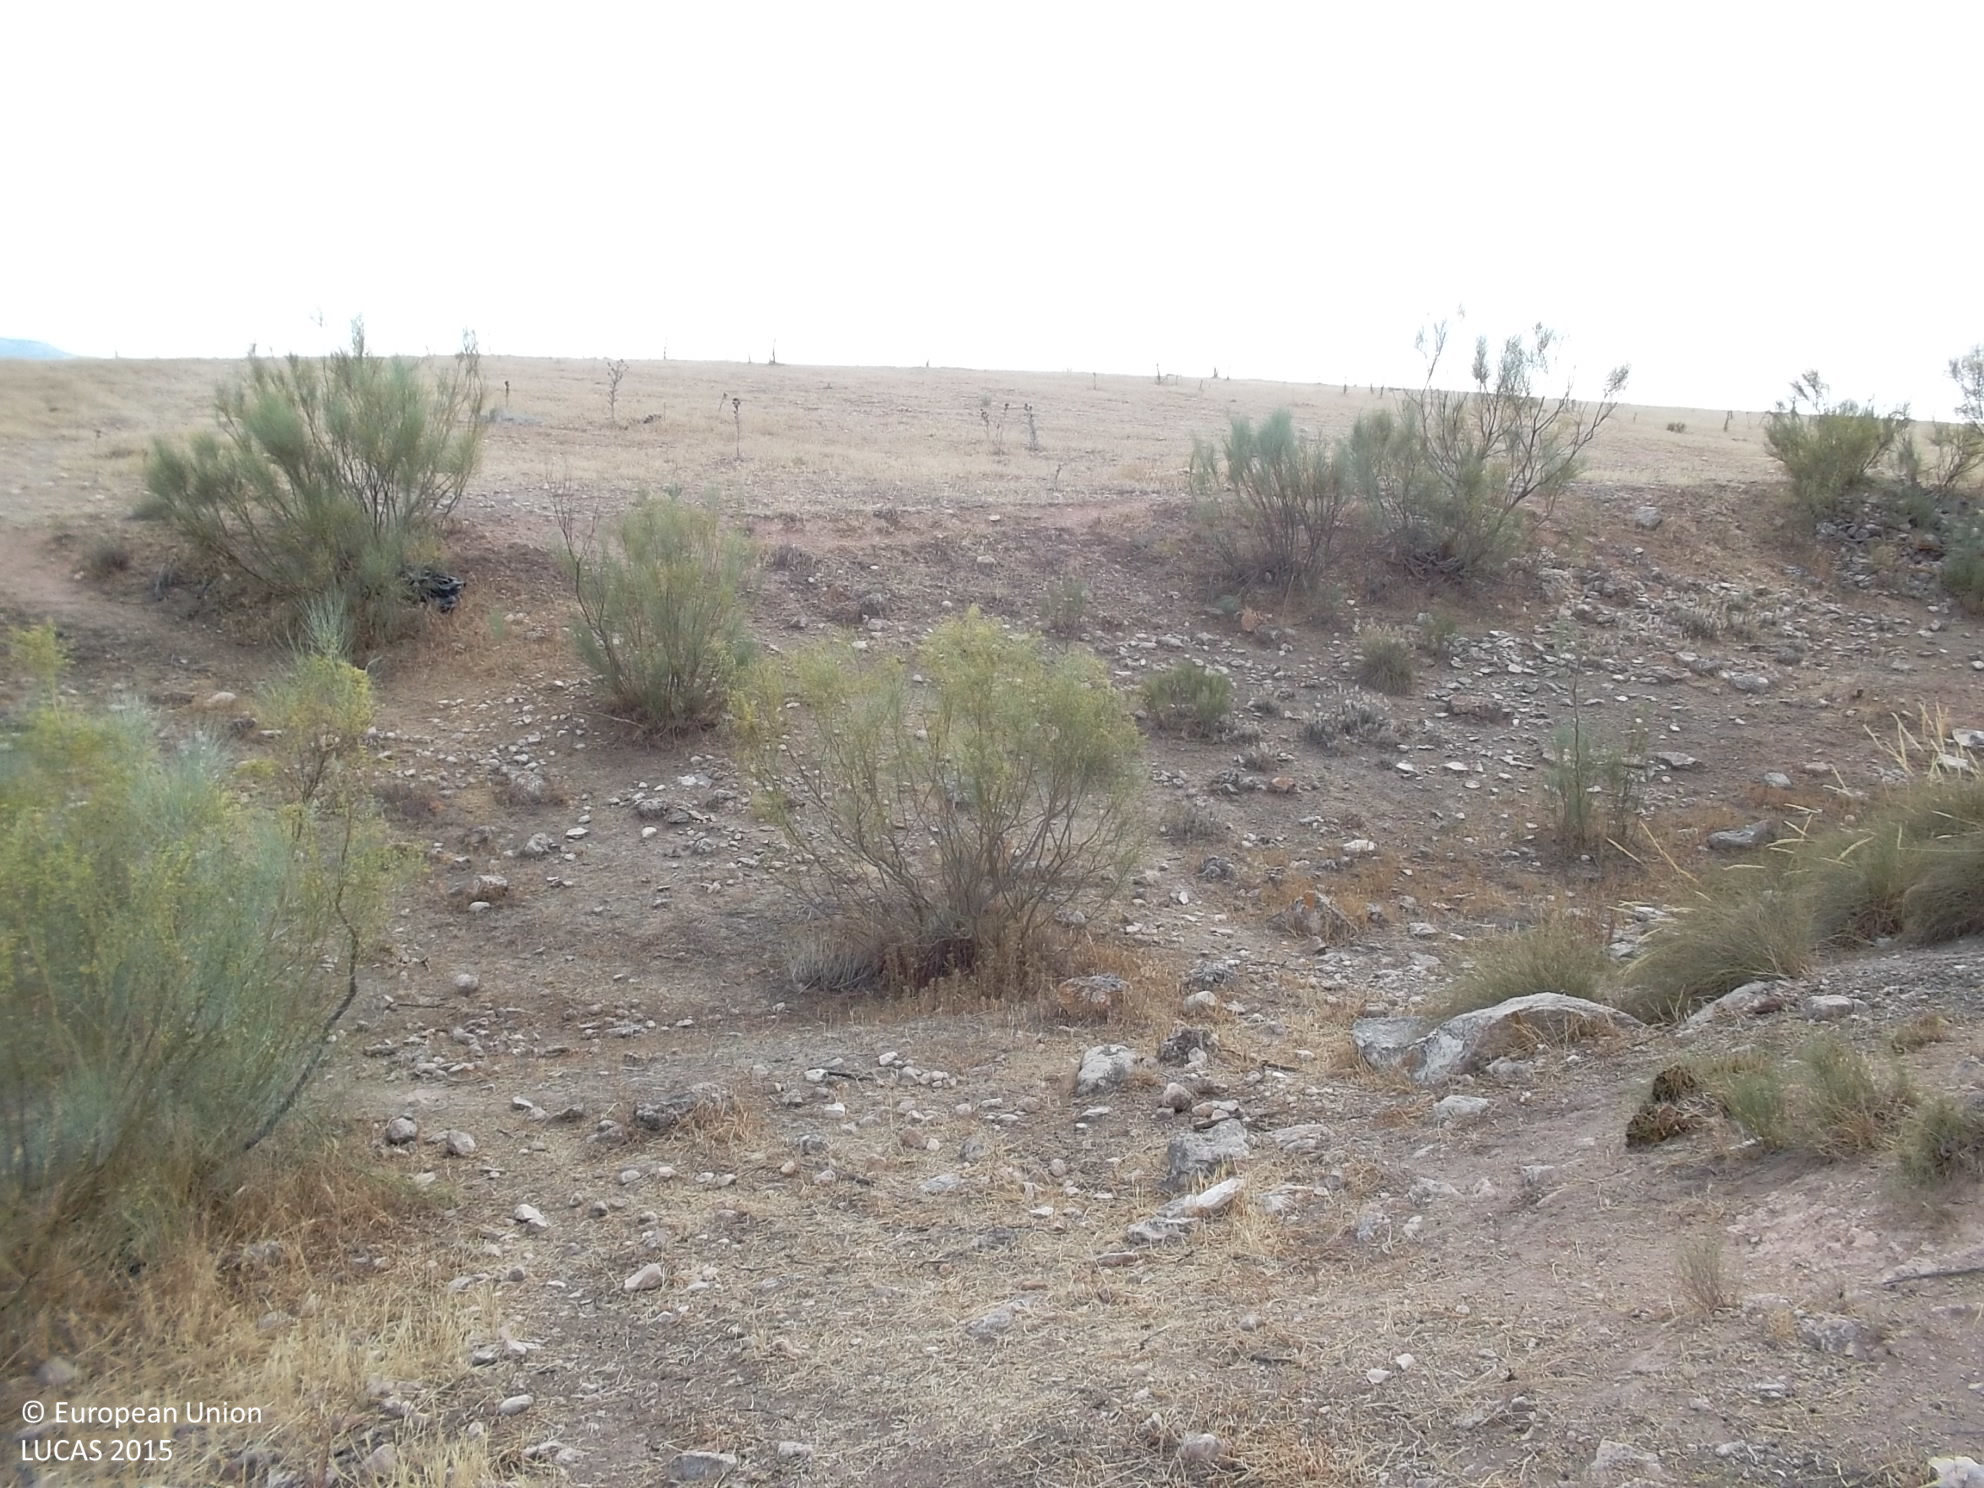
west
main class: Shrubland
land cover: Shrubland without tree cover
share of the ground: 50 - 75 %
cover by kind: herbaceous plants 40 %, shrubs 30 %, unconsolidated bare surface 30 %
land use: Agriculture (excluding fallow land and kitchen gardens)
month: June
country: ES
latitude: 37.6700
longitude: -3.1784
